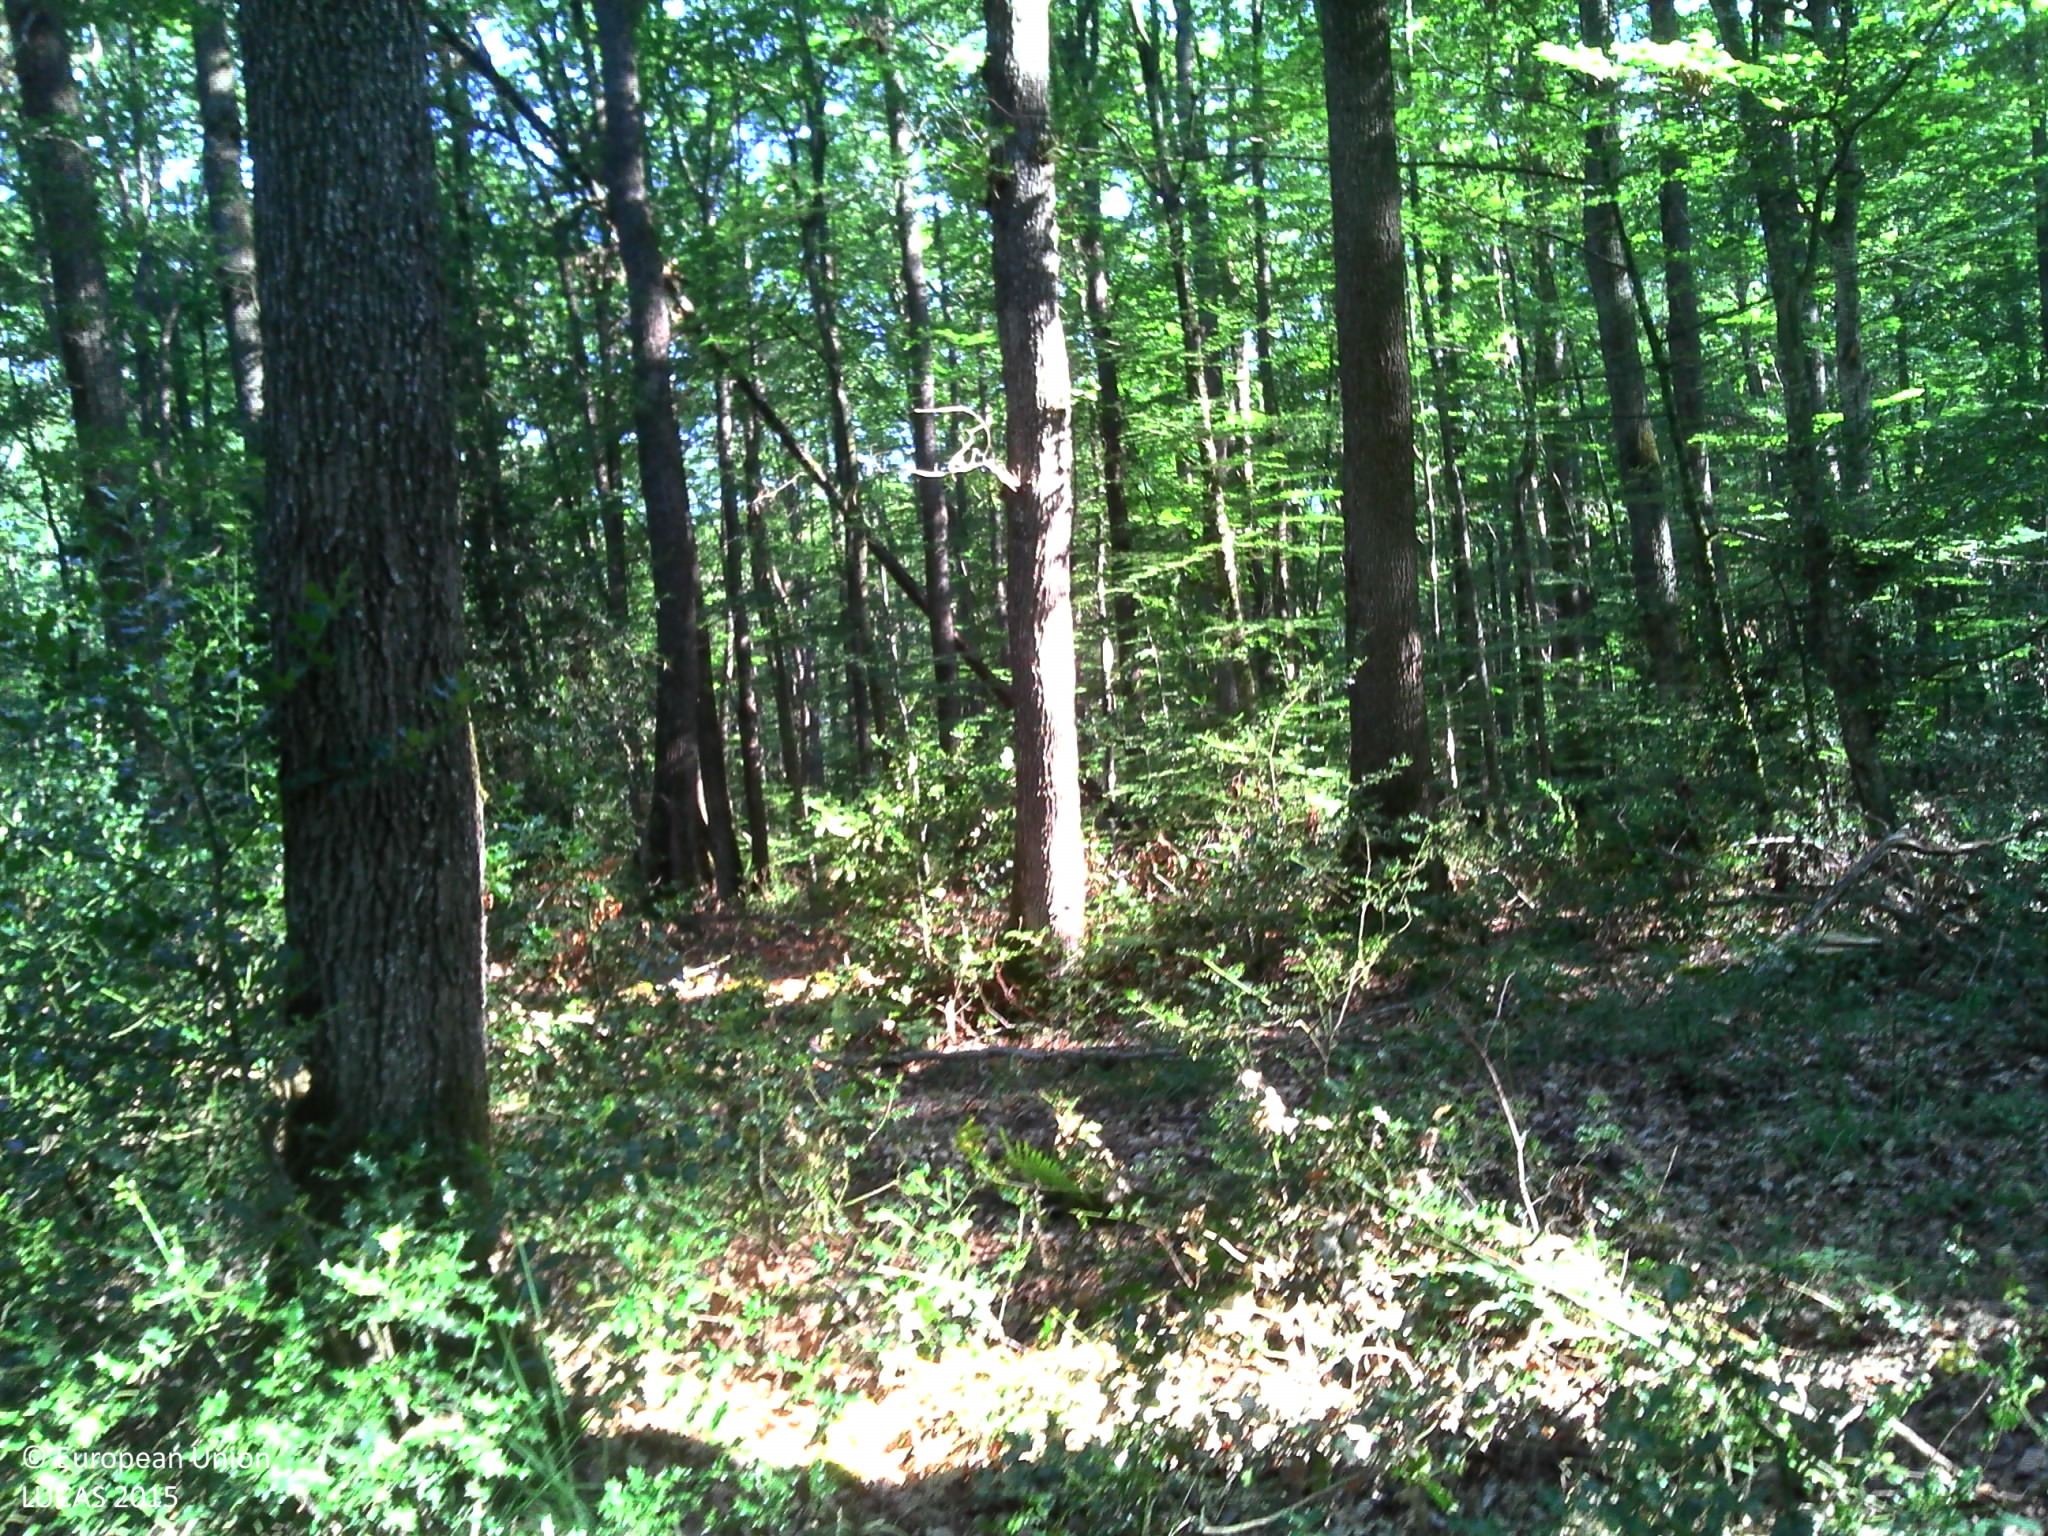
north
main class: Woodland
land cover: Broadleaved woodland
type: mesophytic deciduous forest
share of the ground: > 75 %
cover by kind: broadleaved forest trees 90 %, shrubs 5 %, herbaceous plants 5 %
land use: Forestry
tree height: > 5 m
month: August
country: FR
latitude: 46.6523
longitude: 2.8223
